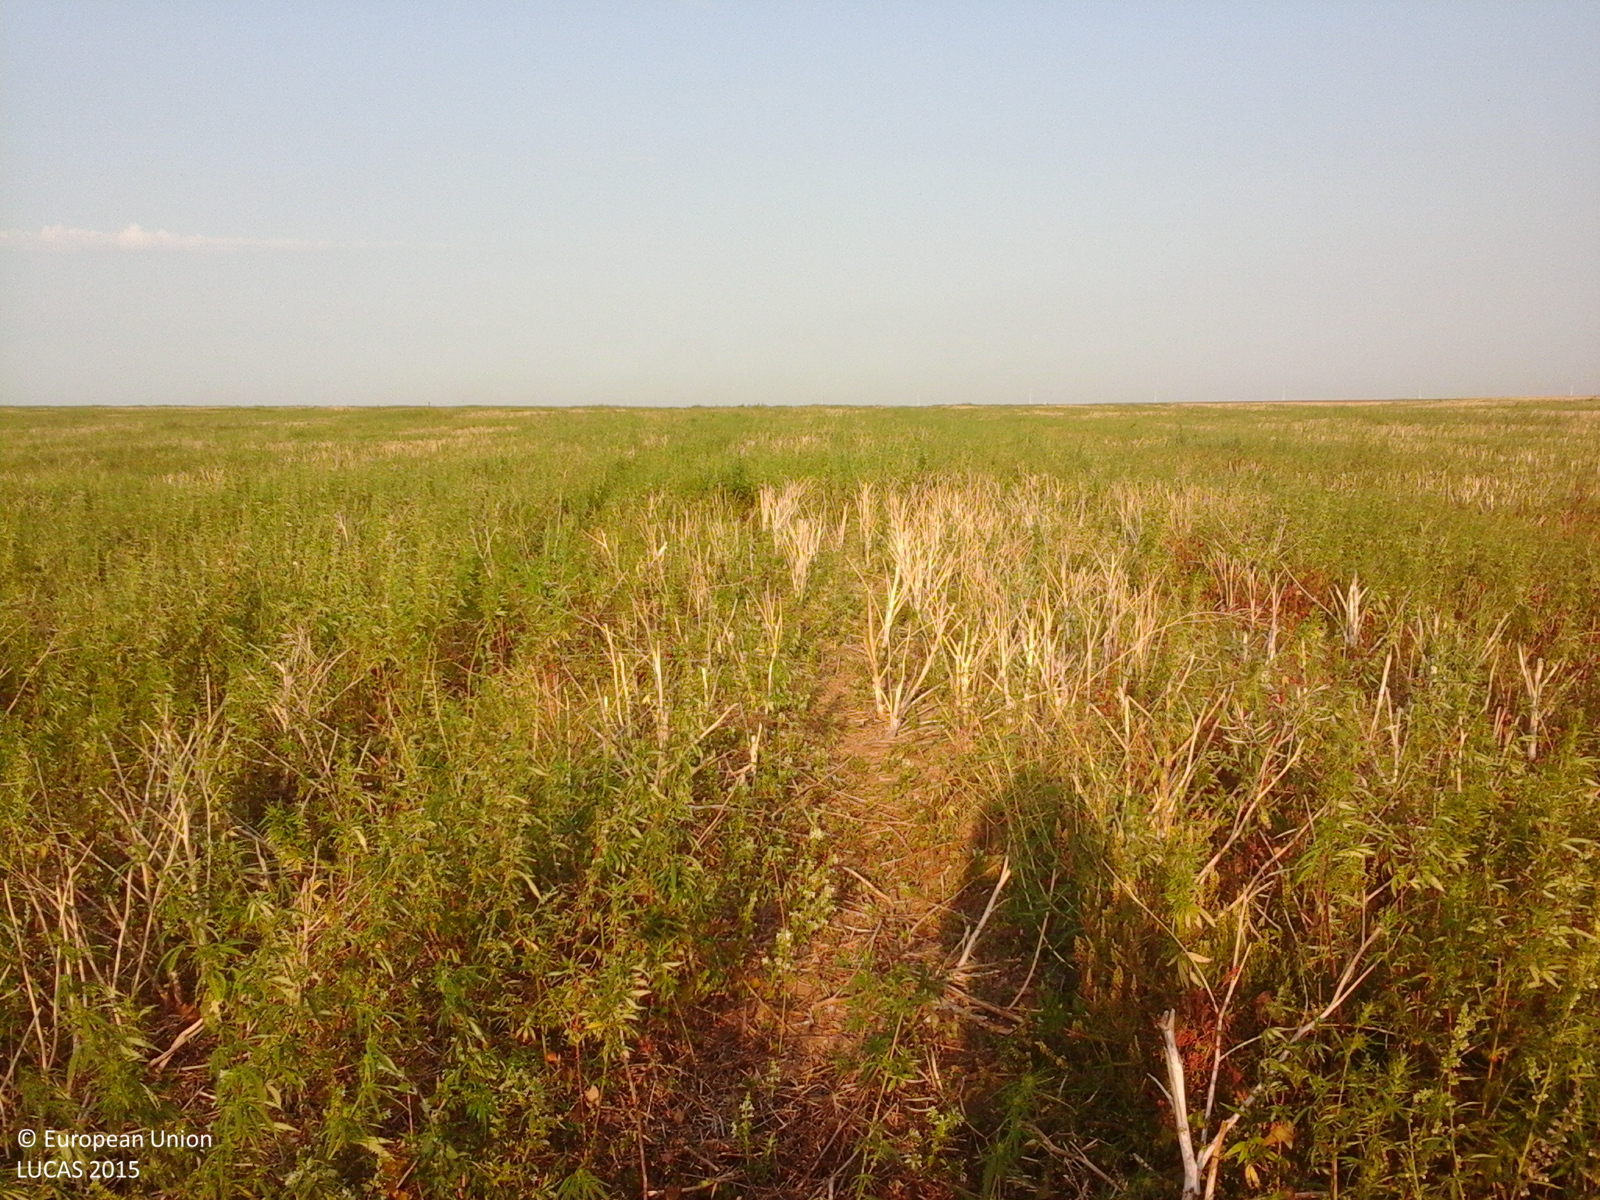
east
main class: Cropland
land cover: Rape and turnip rape
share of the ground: > 75 %
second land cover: Spontaneously vegetated surfaces
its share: 50 - 75 %
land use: Agriculture (excluding fallow land and kitchen gardens)
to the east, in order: Rape and turnip rape; Spontaneously vegetated surfaces
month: August
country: RO
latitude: 44.0451
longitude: 28.1409
